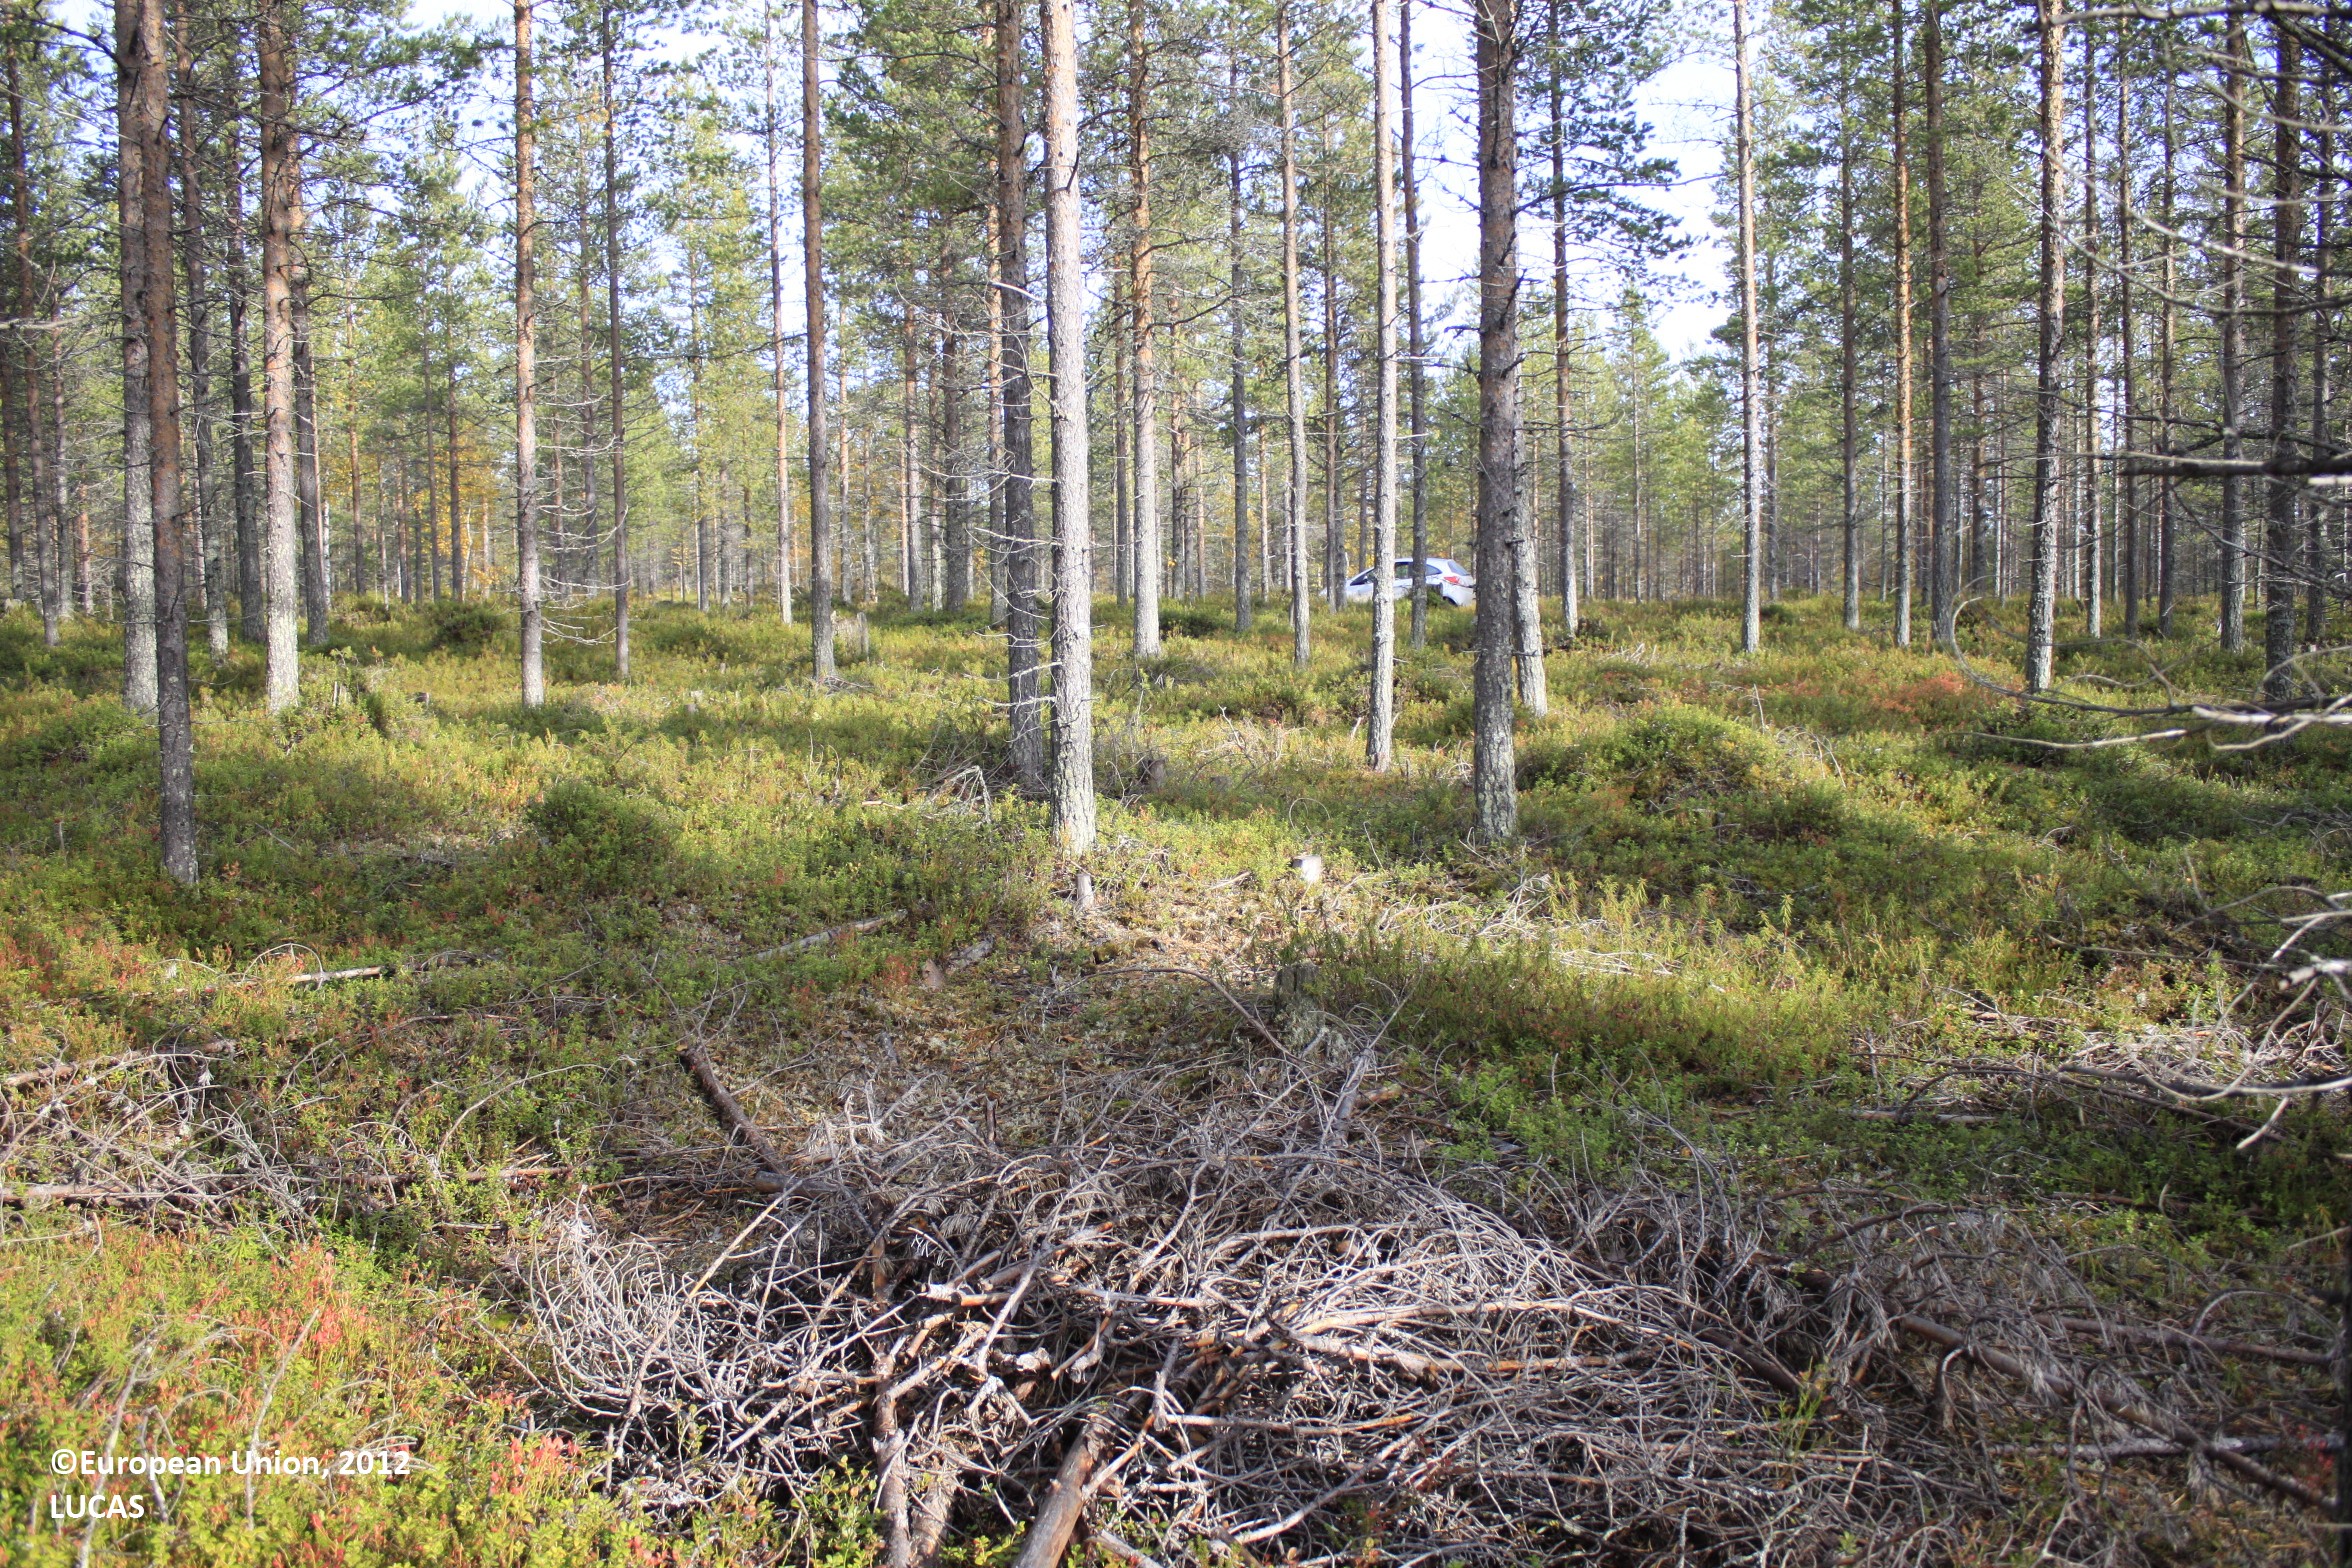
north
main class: Woodland
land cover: Pine dominated coniferous woodland
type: boreal forest
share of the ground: 25 - 50 %
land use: Forestry
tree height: > 5 m
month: September
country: FI
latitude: 66.0070
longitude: 27.2842
